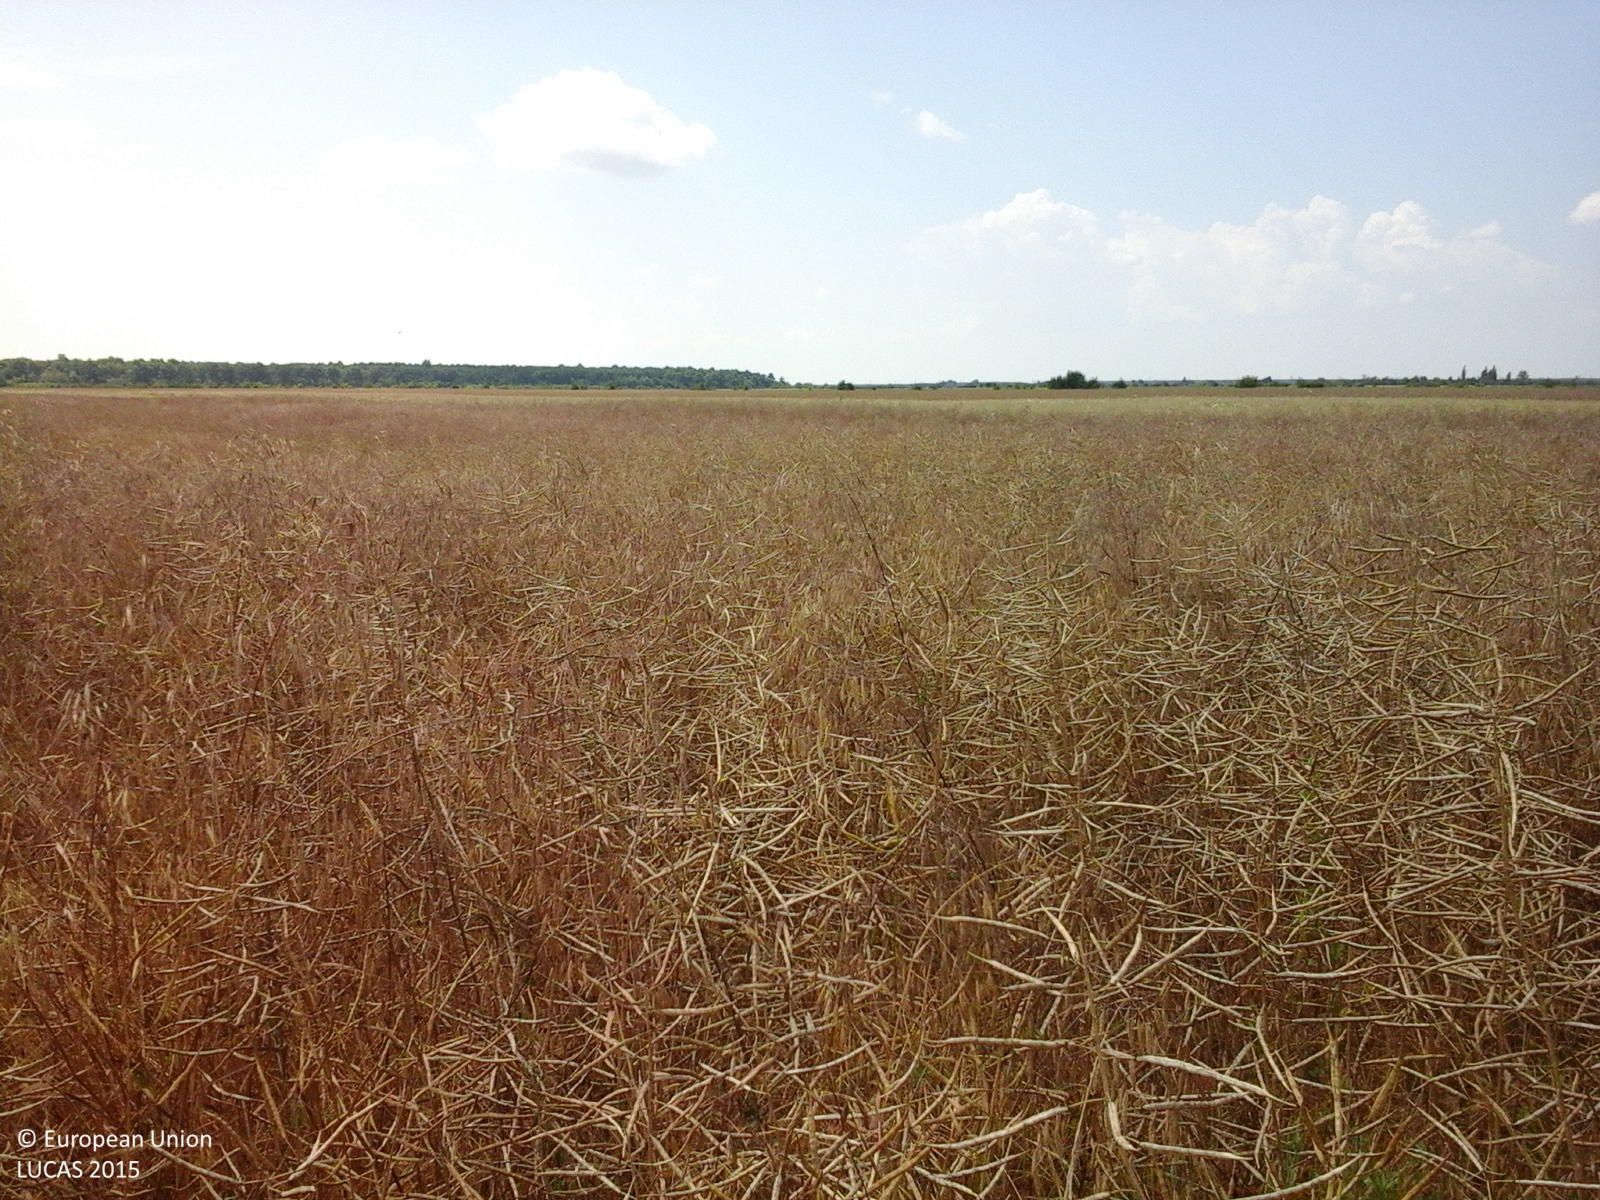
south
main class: Cropland
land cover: Rape and turnip rape
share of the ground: > 75 %
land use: Agriculture (excluding fallow land and kitchen gardens)
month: July
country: RO
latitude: 44.4831
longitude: 25.5967
